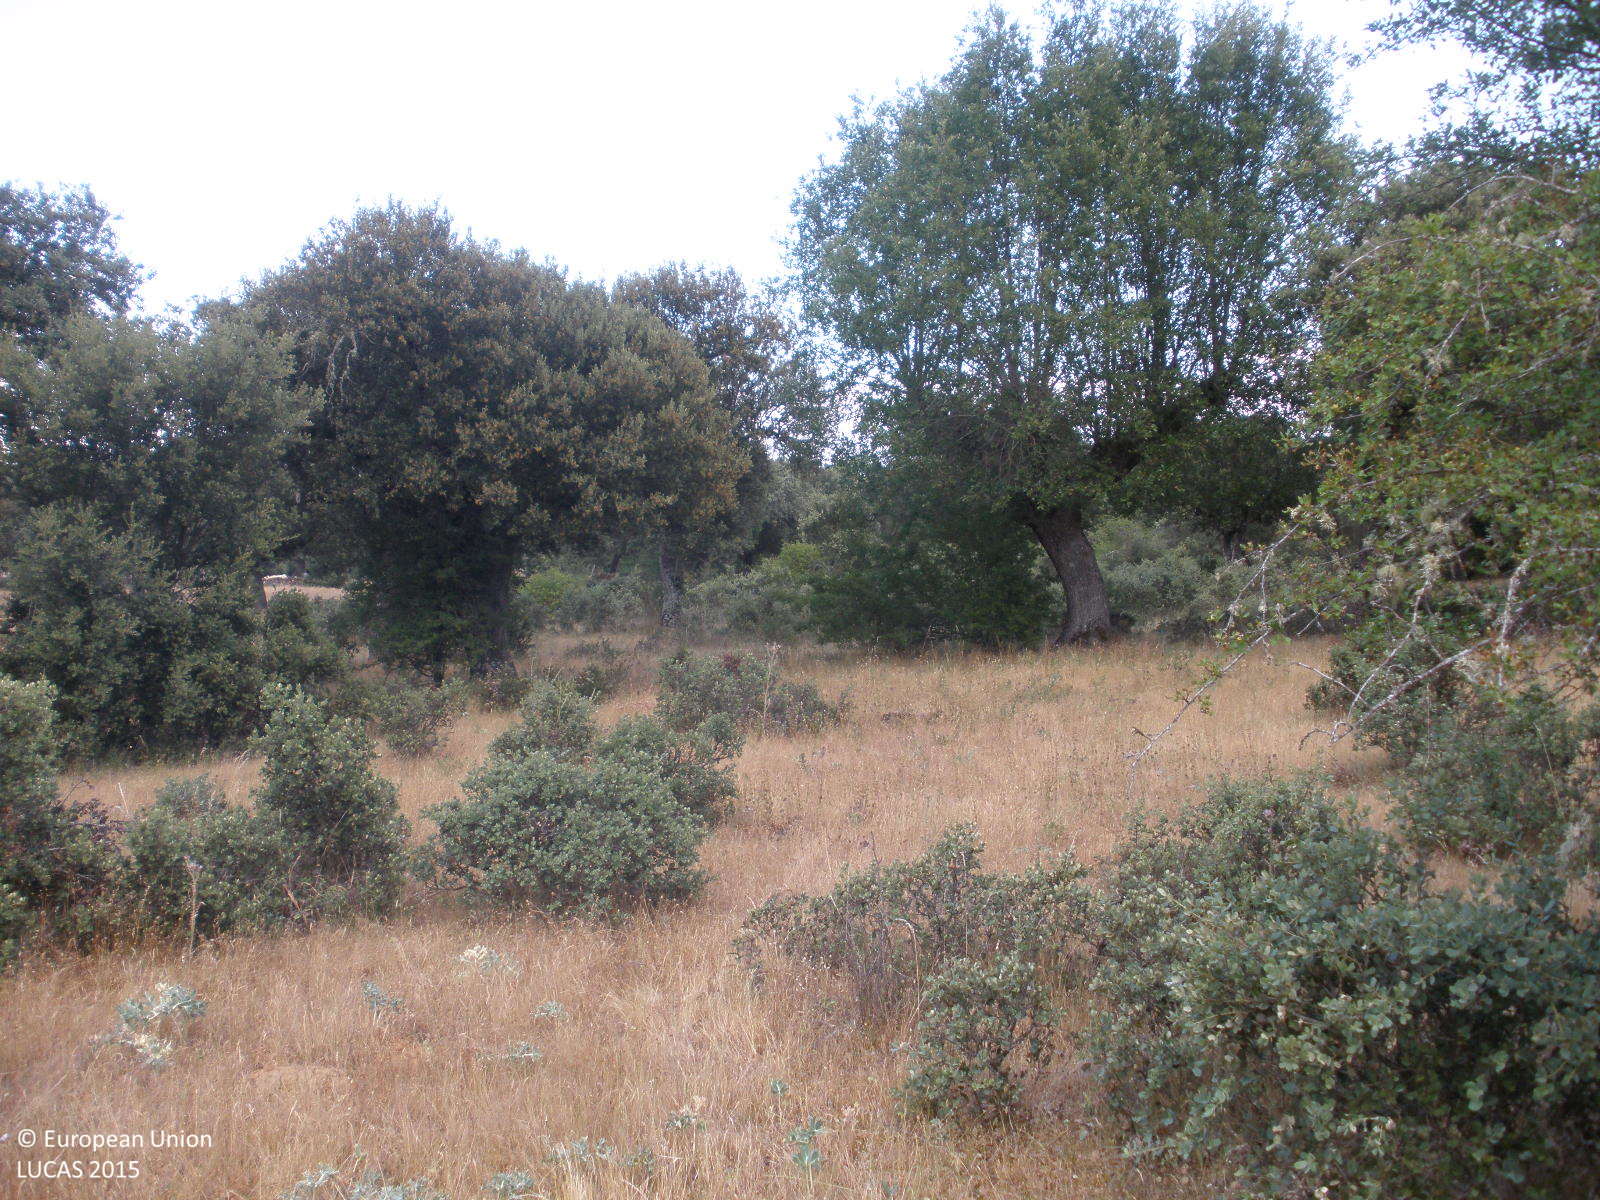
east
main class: Woodland
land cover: Broadleaved woodland
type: broadleaved evergreen forest
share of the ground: > 75 %
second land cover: Grassland without tree/shrub cover
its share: > 75 %
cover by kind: broadleaved forest trees 60 %, herbaceous plants 30 %, shrubs 10 %
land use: Forestry
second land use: Agriculture (excluding fallow land and kitchen gardens)
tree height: < 5 m
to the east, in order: Broadleaved woodland; Grassland without tree/shrub cover; Tracks; Broadleaved woodland; Fences; Dry stone walls; Broadleaved woodland; Fences; Broadleaved woodland
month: June
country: ES
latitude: 40.7251
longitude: -6.2464
